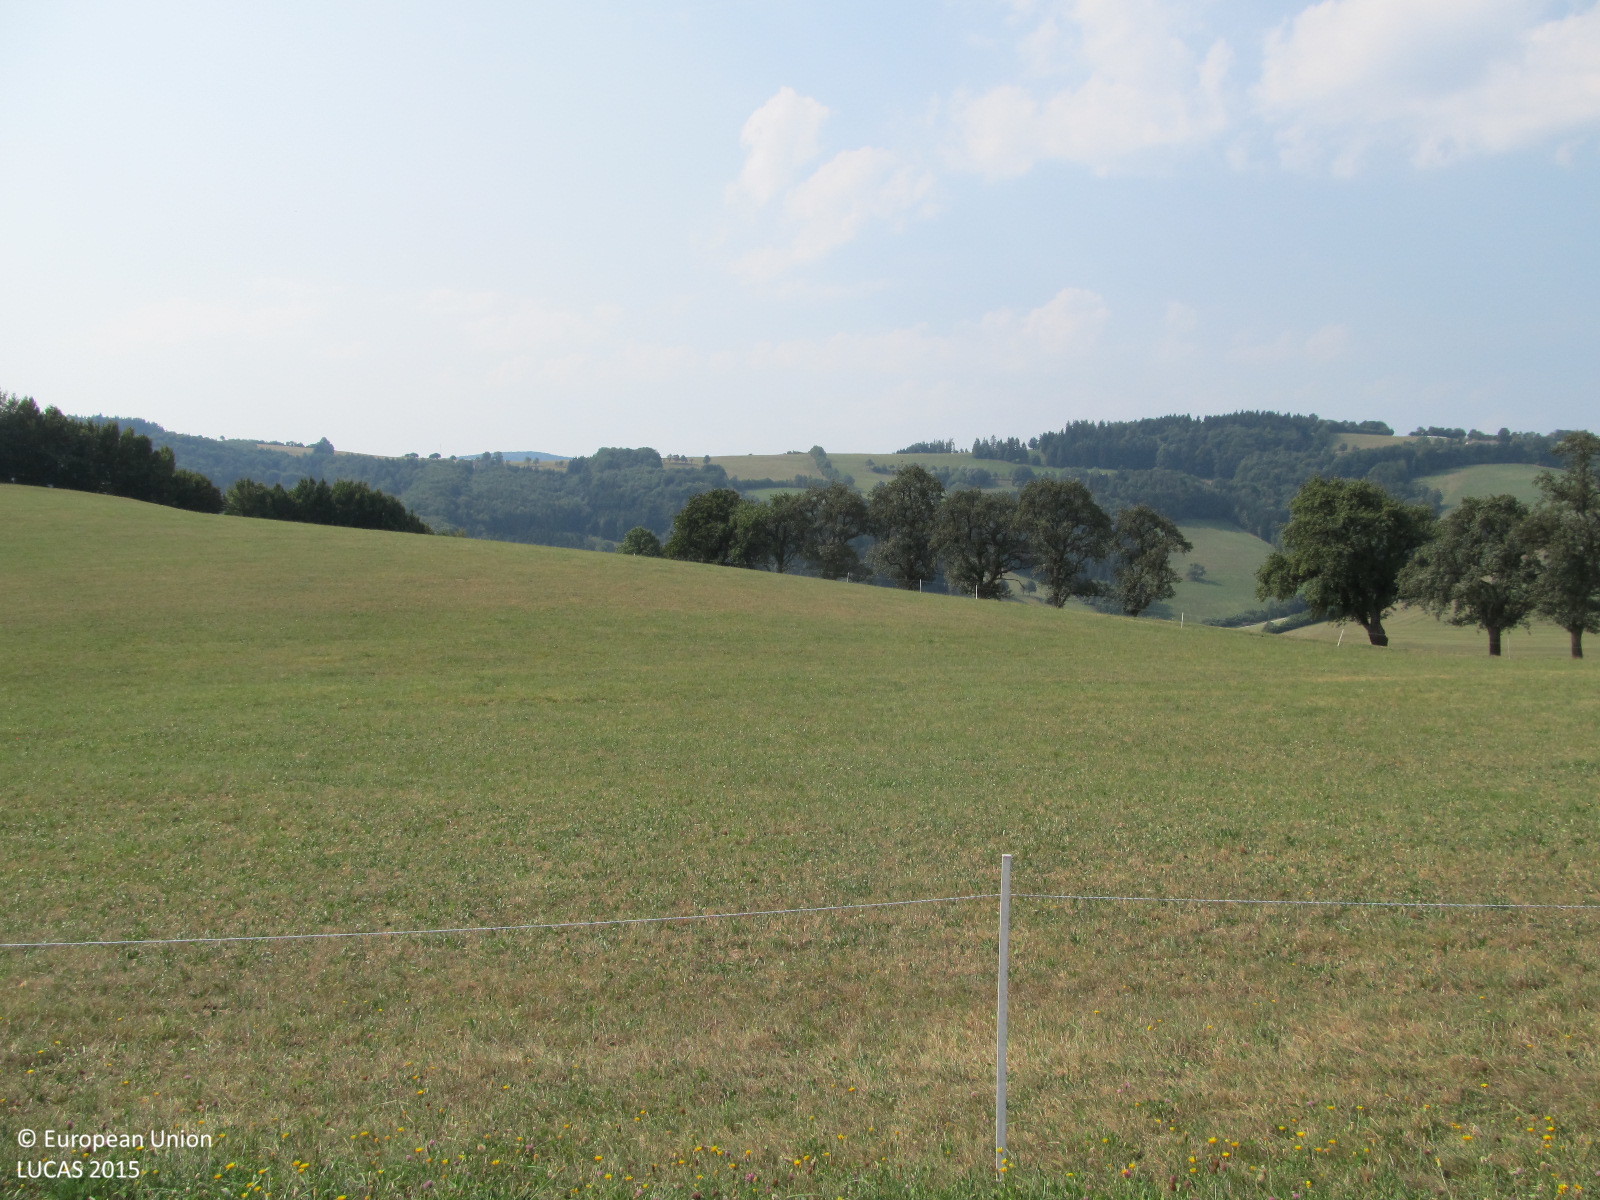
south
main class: Grassland
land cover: Grassland without tree/shrub cover
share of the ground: > 75 %
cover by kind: herbaceous plants 100 %
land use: Agriculture (excluding fallow land and kitchen gardens)
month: August
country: AT
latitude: 48.0826
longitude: 15.5732
